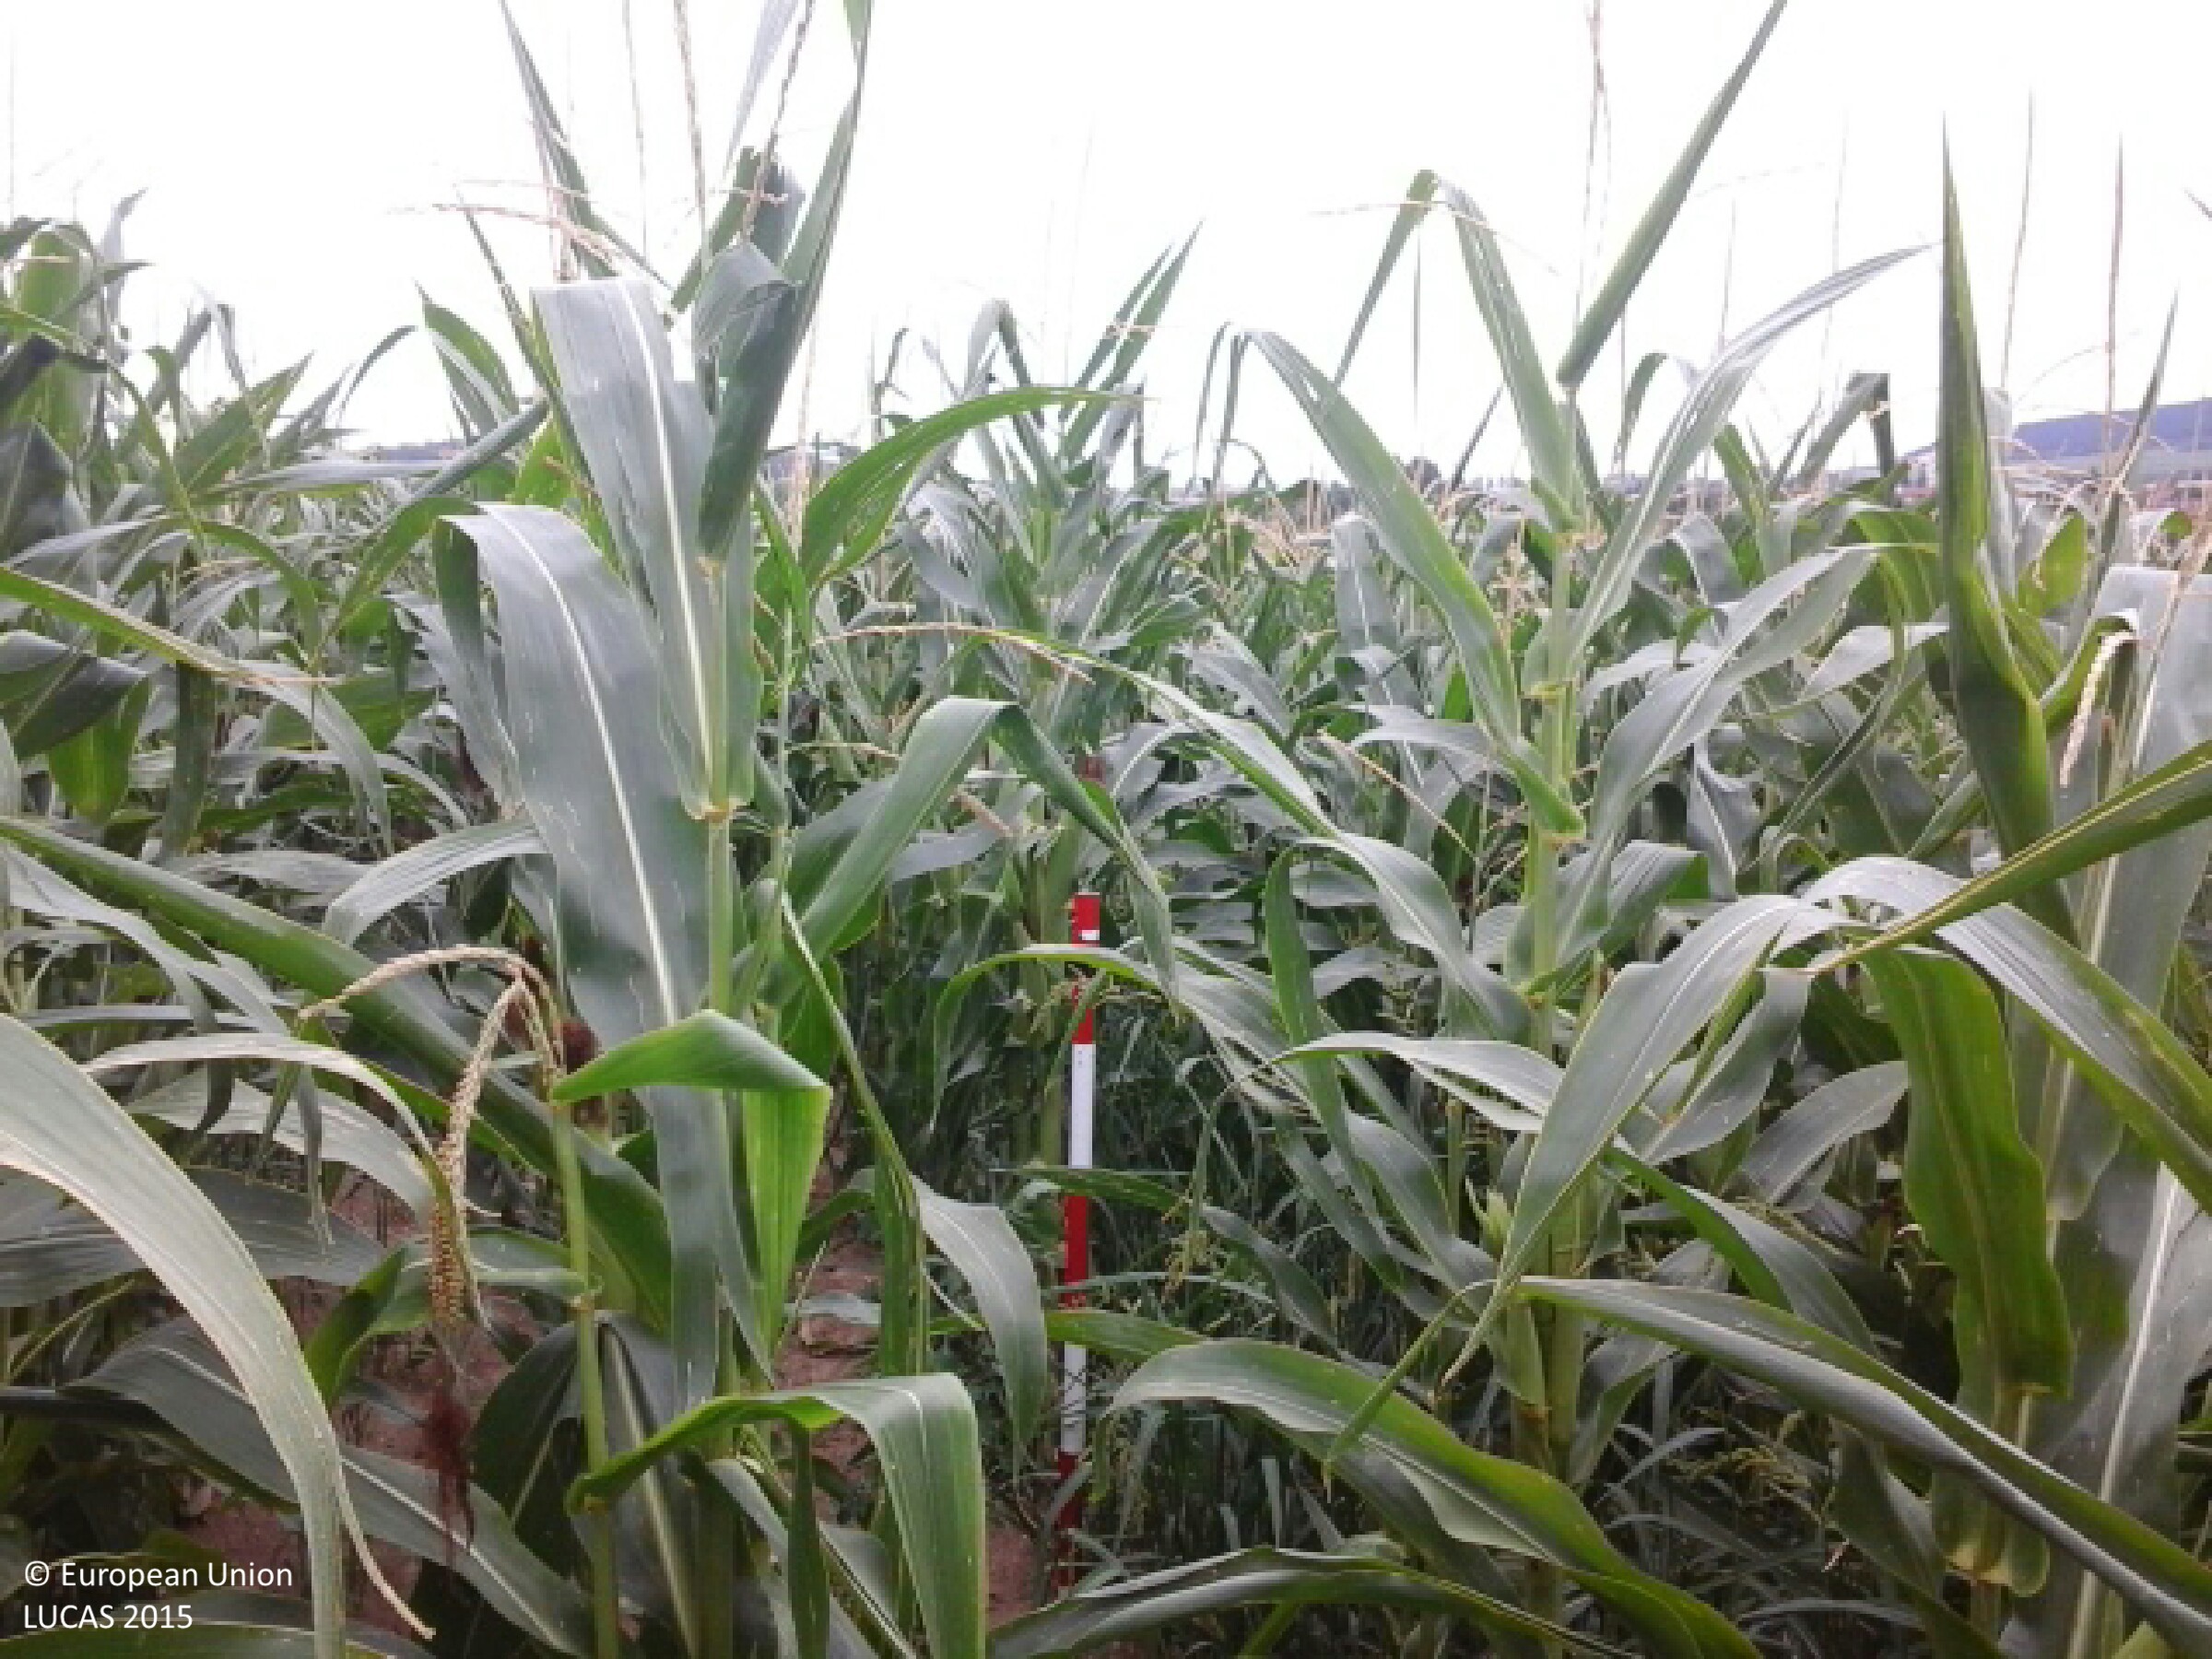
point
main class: Cropland
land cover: Maize
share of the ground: > 75 %
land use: Agriculture (excluding fallow land and kitchen gardens)
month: July
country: HU
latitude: 48.3434
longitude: 21.5288
